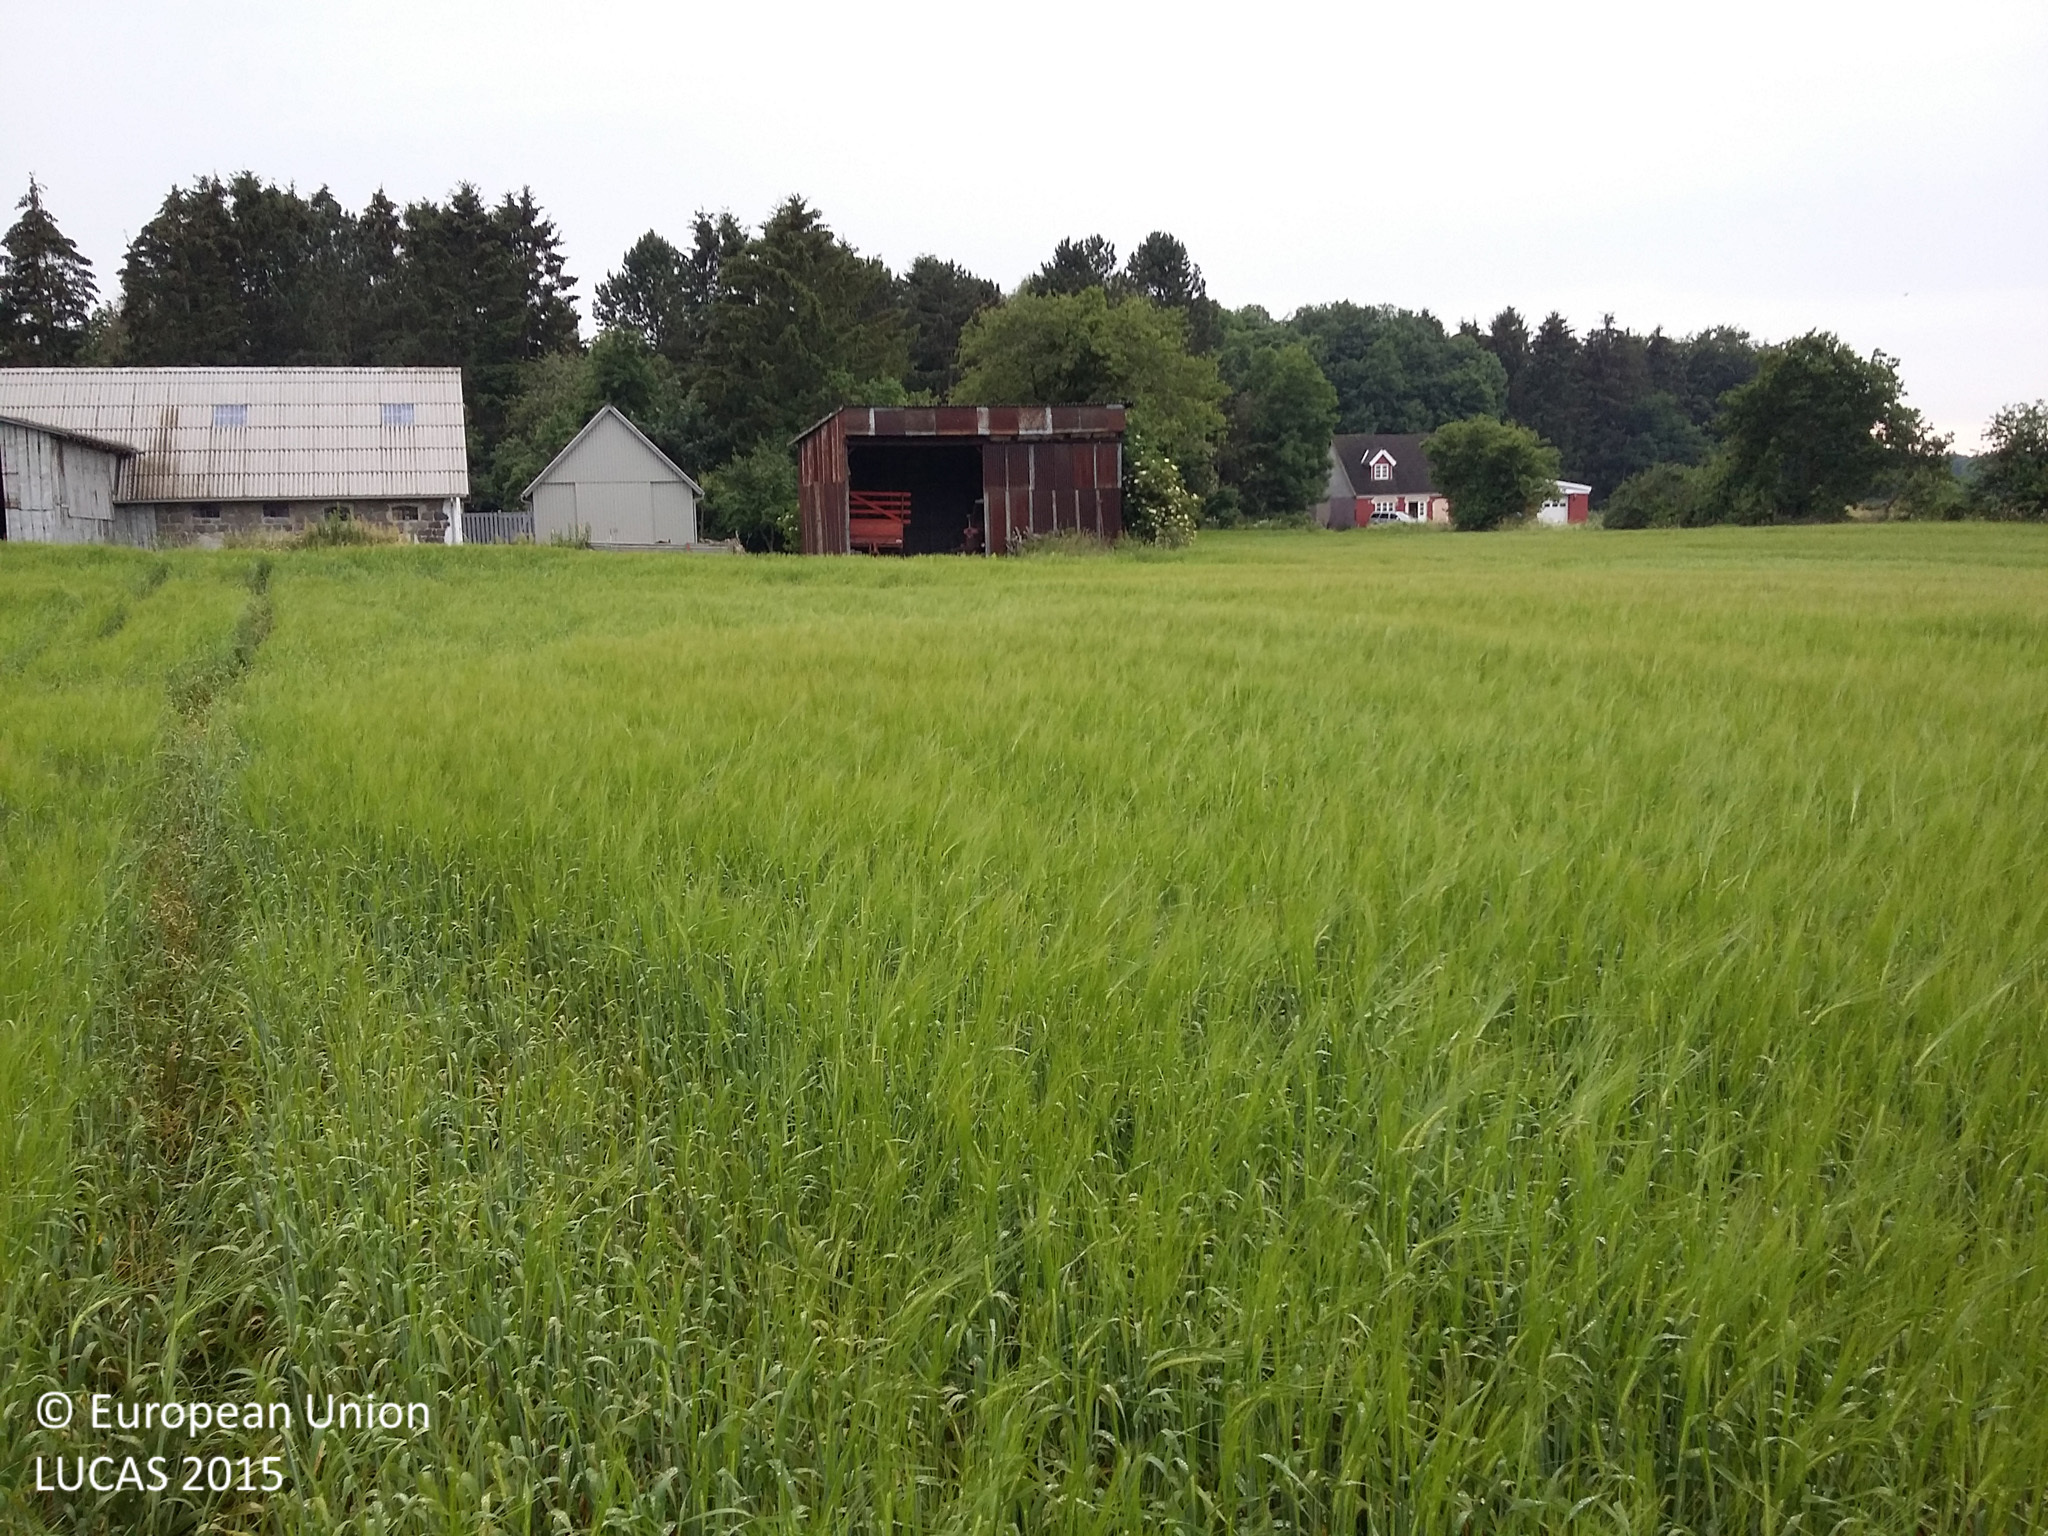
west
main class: Cropland
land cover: Barley
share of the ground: > 75 %
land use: Agriculture (excluding fallow land and kitchen gardens)
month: July
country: DK
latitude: 55.3145
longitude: 11.6216
